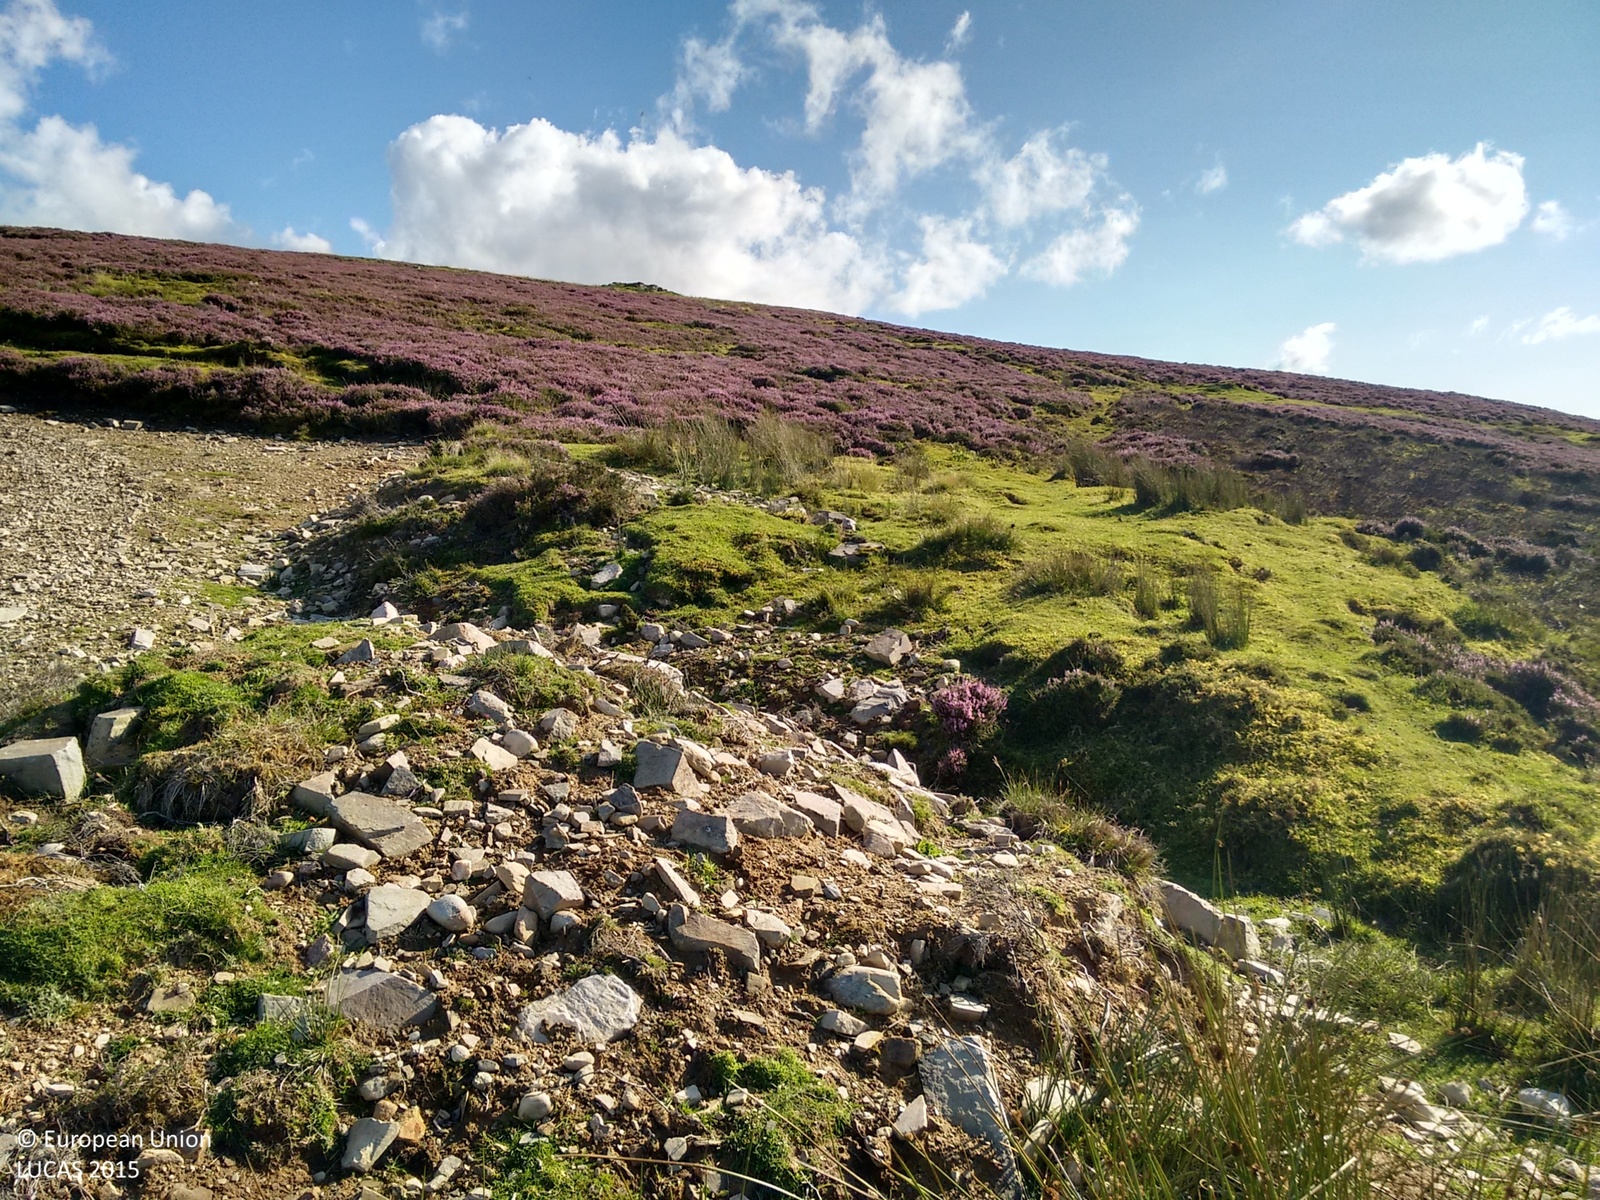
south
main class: Shrubland
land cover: Shrubland without tree cover
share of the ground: > 75 %
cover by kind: herbaceous plants 70 %, shrubs 20 %, consolidated bare surface 10 %
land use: Agriculture (excluding fallow land and kitchen gardens)
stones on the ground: > 50 %
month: September
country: GB
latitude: 57.3354
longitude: -3.4770
